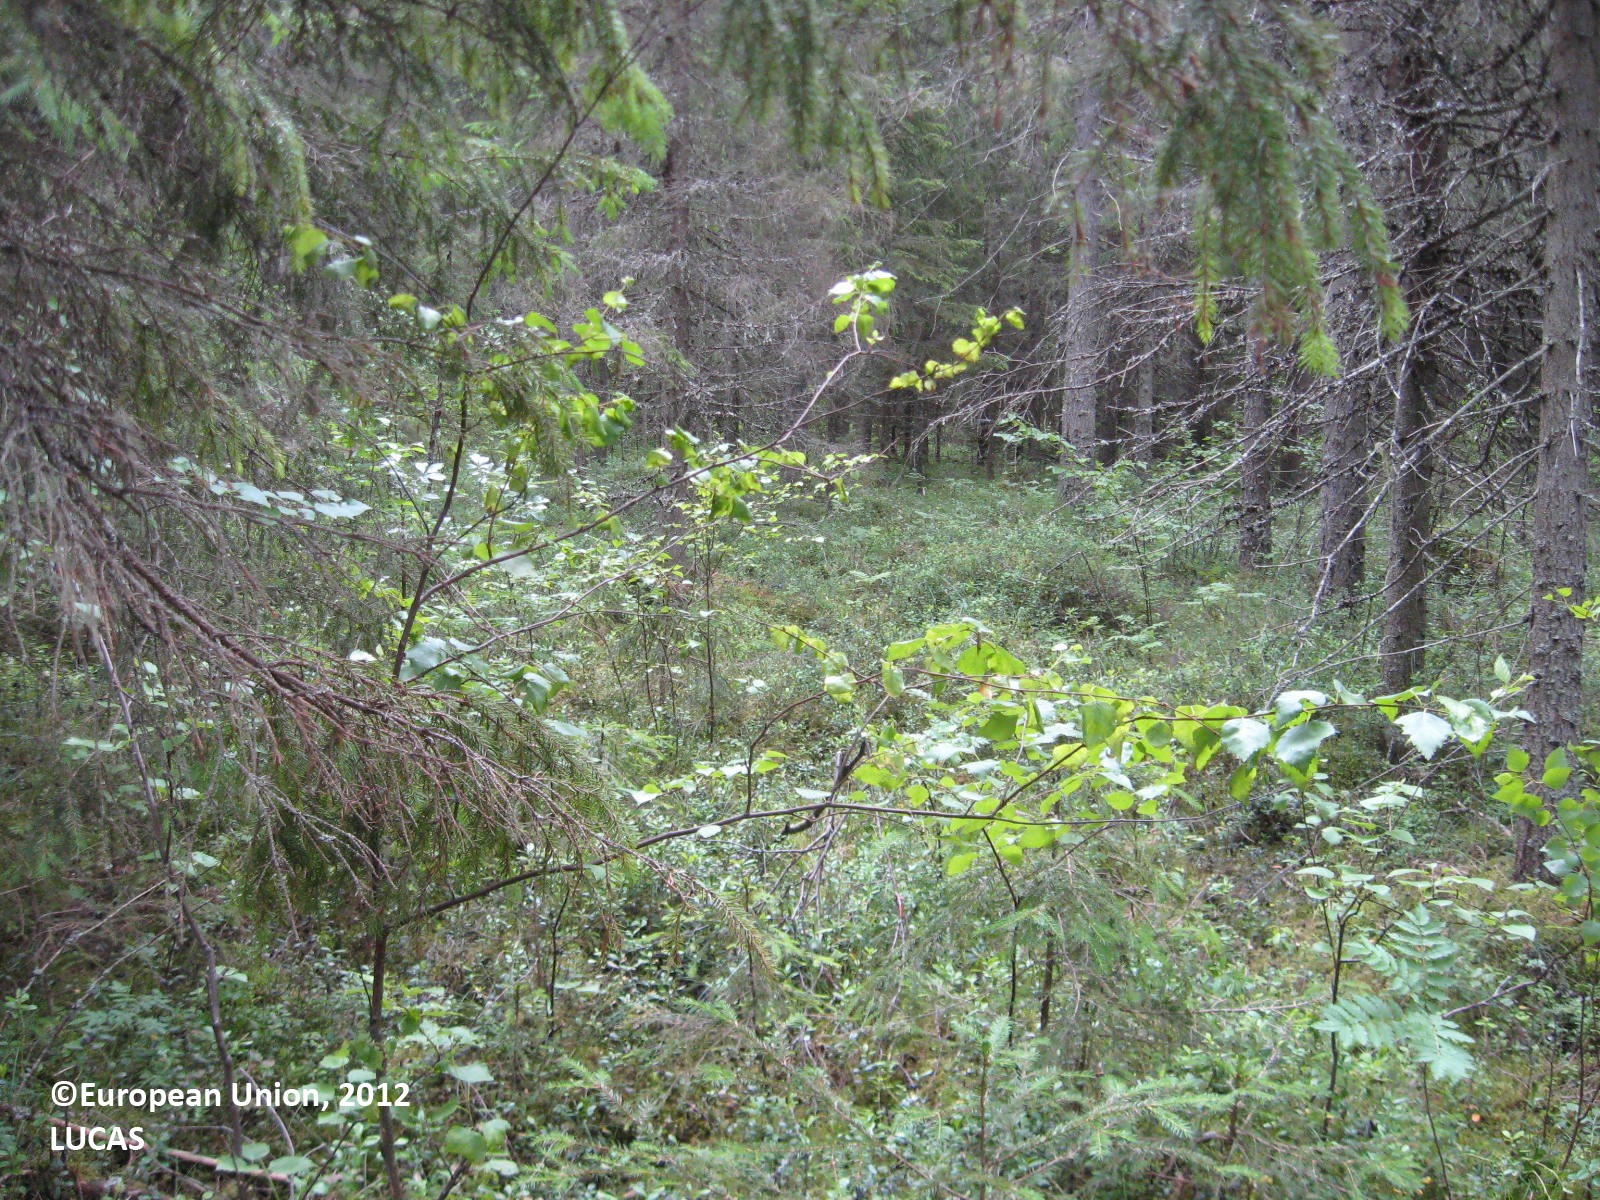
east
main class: Woodland
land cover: Spruce dominated coniferous woodland
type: boreal forest
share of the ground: > 75 %
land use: Forestry
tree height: > 5 m
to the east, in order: Spruce dominated coniferous woodland; Ditches and canals; Pine dominated coniferous woodland; Ditches and canals; Pine dominated mixed woodland
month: July
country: FI
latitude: 62.5125
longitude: 21.5604
